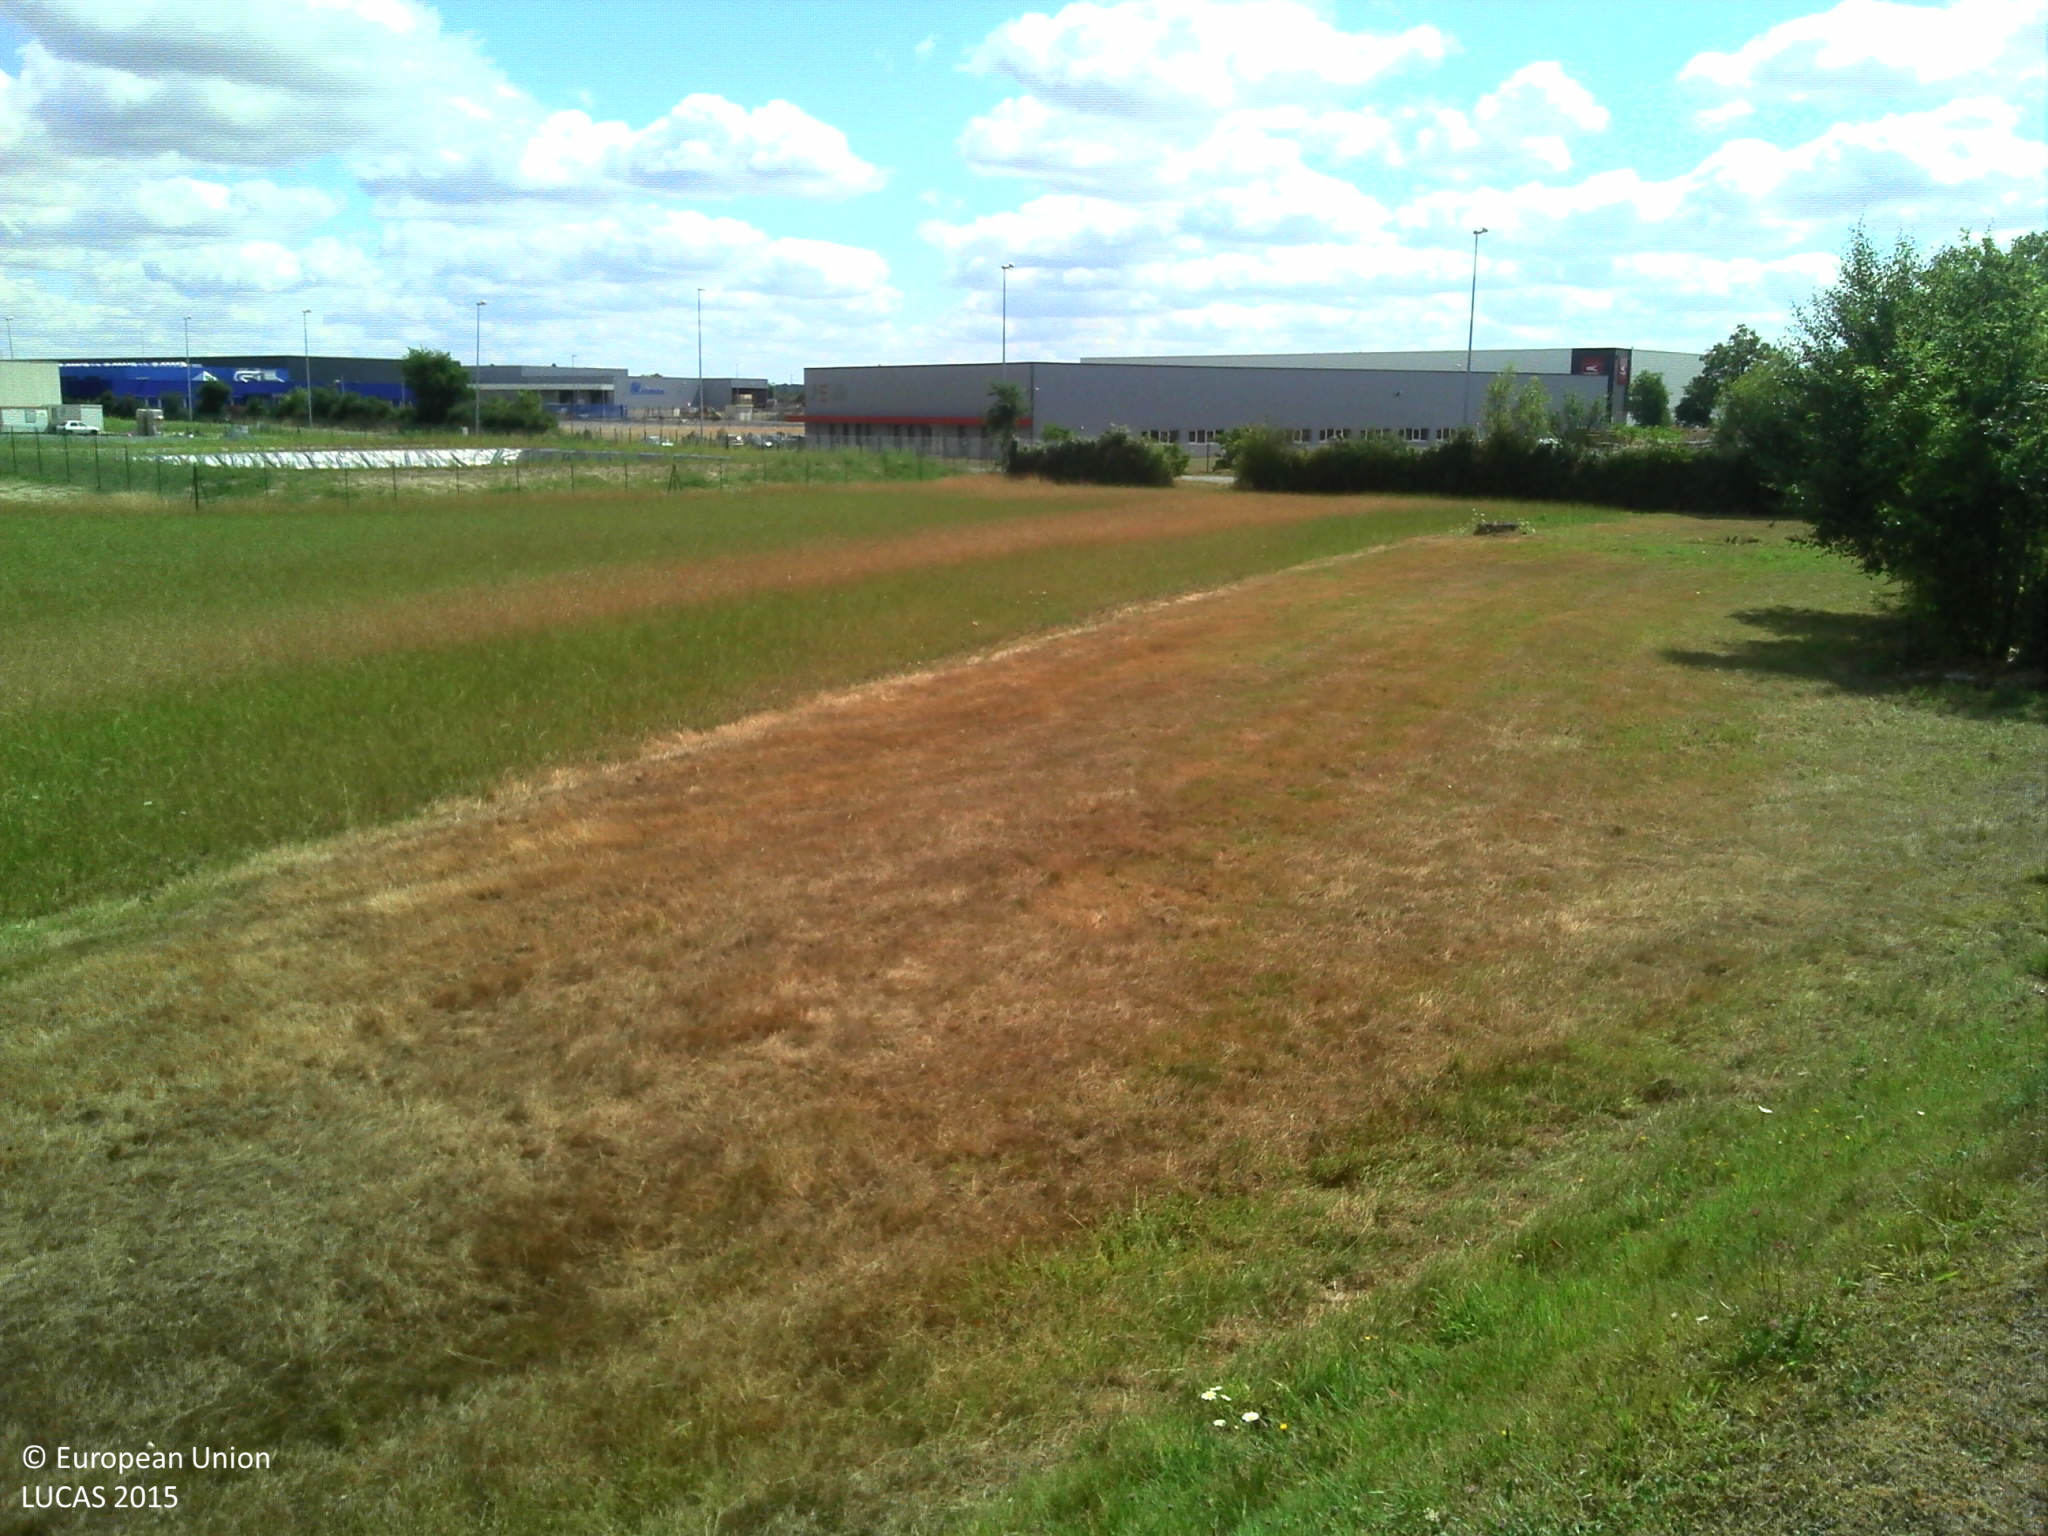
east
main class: Grassland
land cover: Grassland without tree/shrub cover
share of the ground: > 75 %
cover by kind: herbaceous plants 100 %
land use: Water supply and treatment
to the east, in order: Grassland without tree/shrub cover; Abandoned hedges; Ditches and canals; Artificial constructions in urban areas; Ditches and canals; Grassland without tree/shrub cover; Grass margins
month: July
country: FR
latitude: 46.9879
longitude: -0.9333
